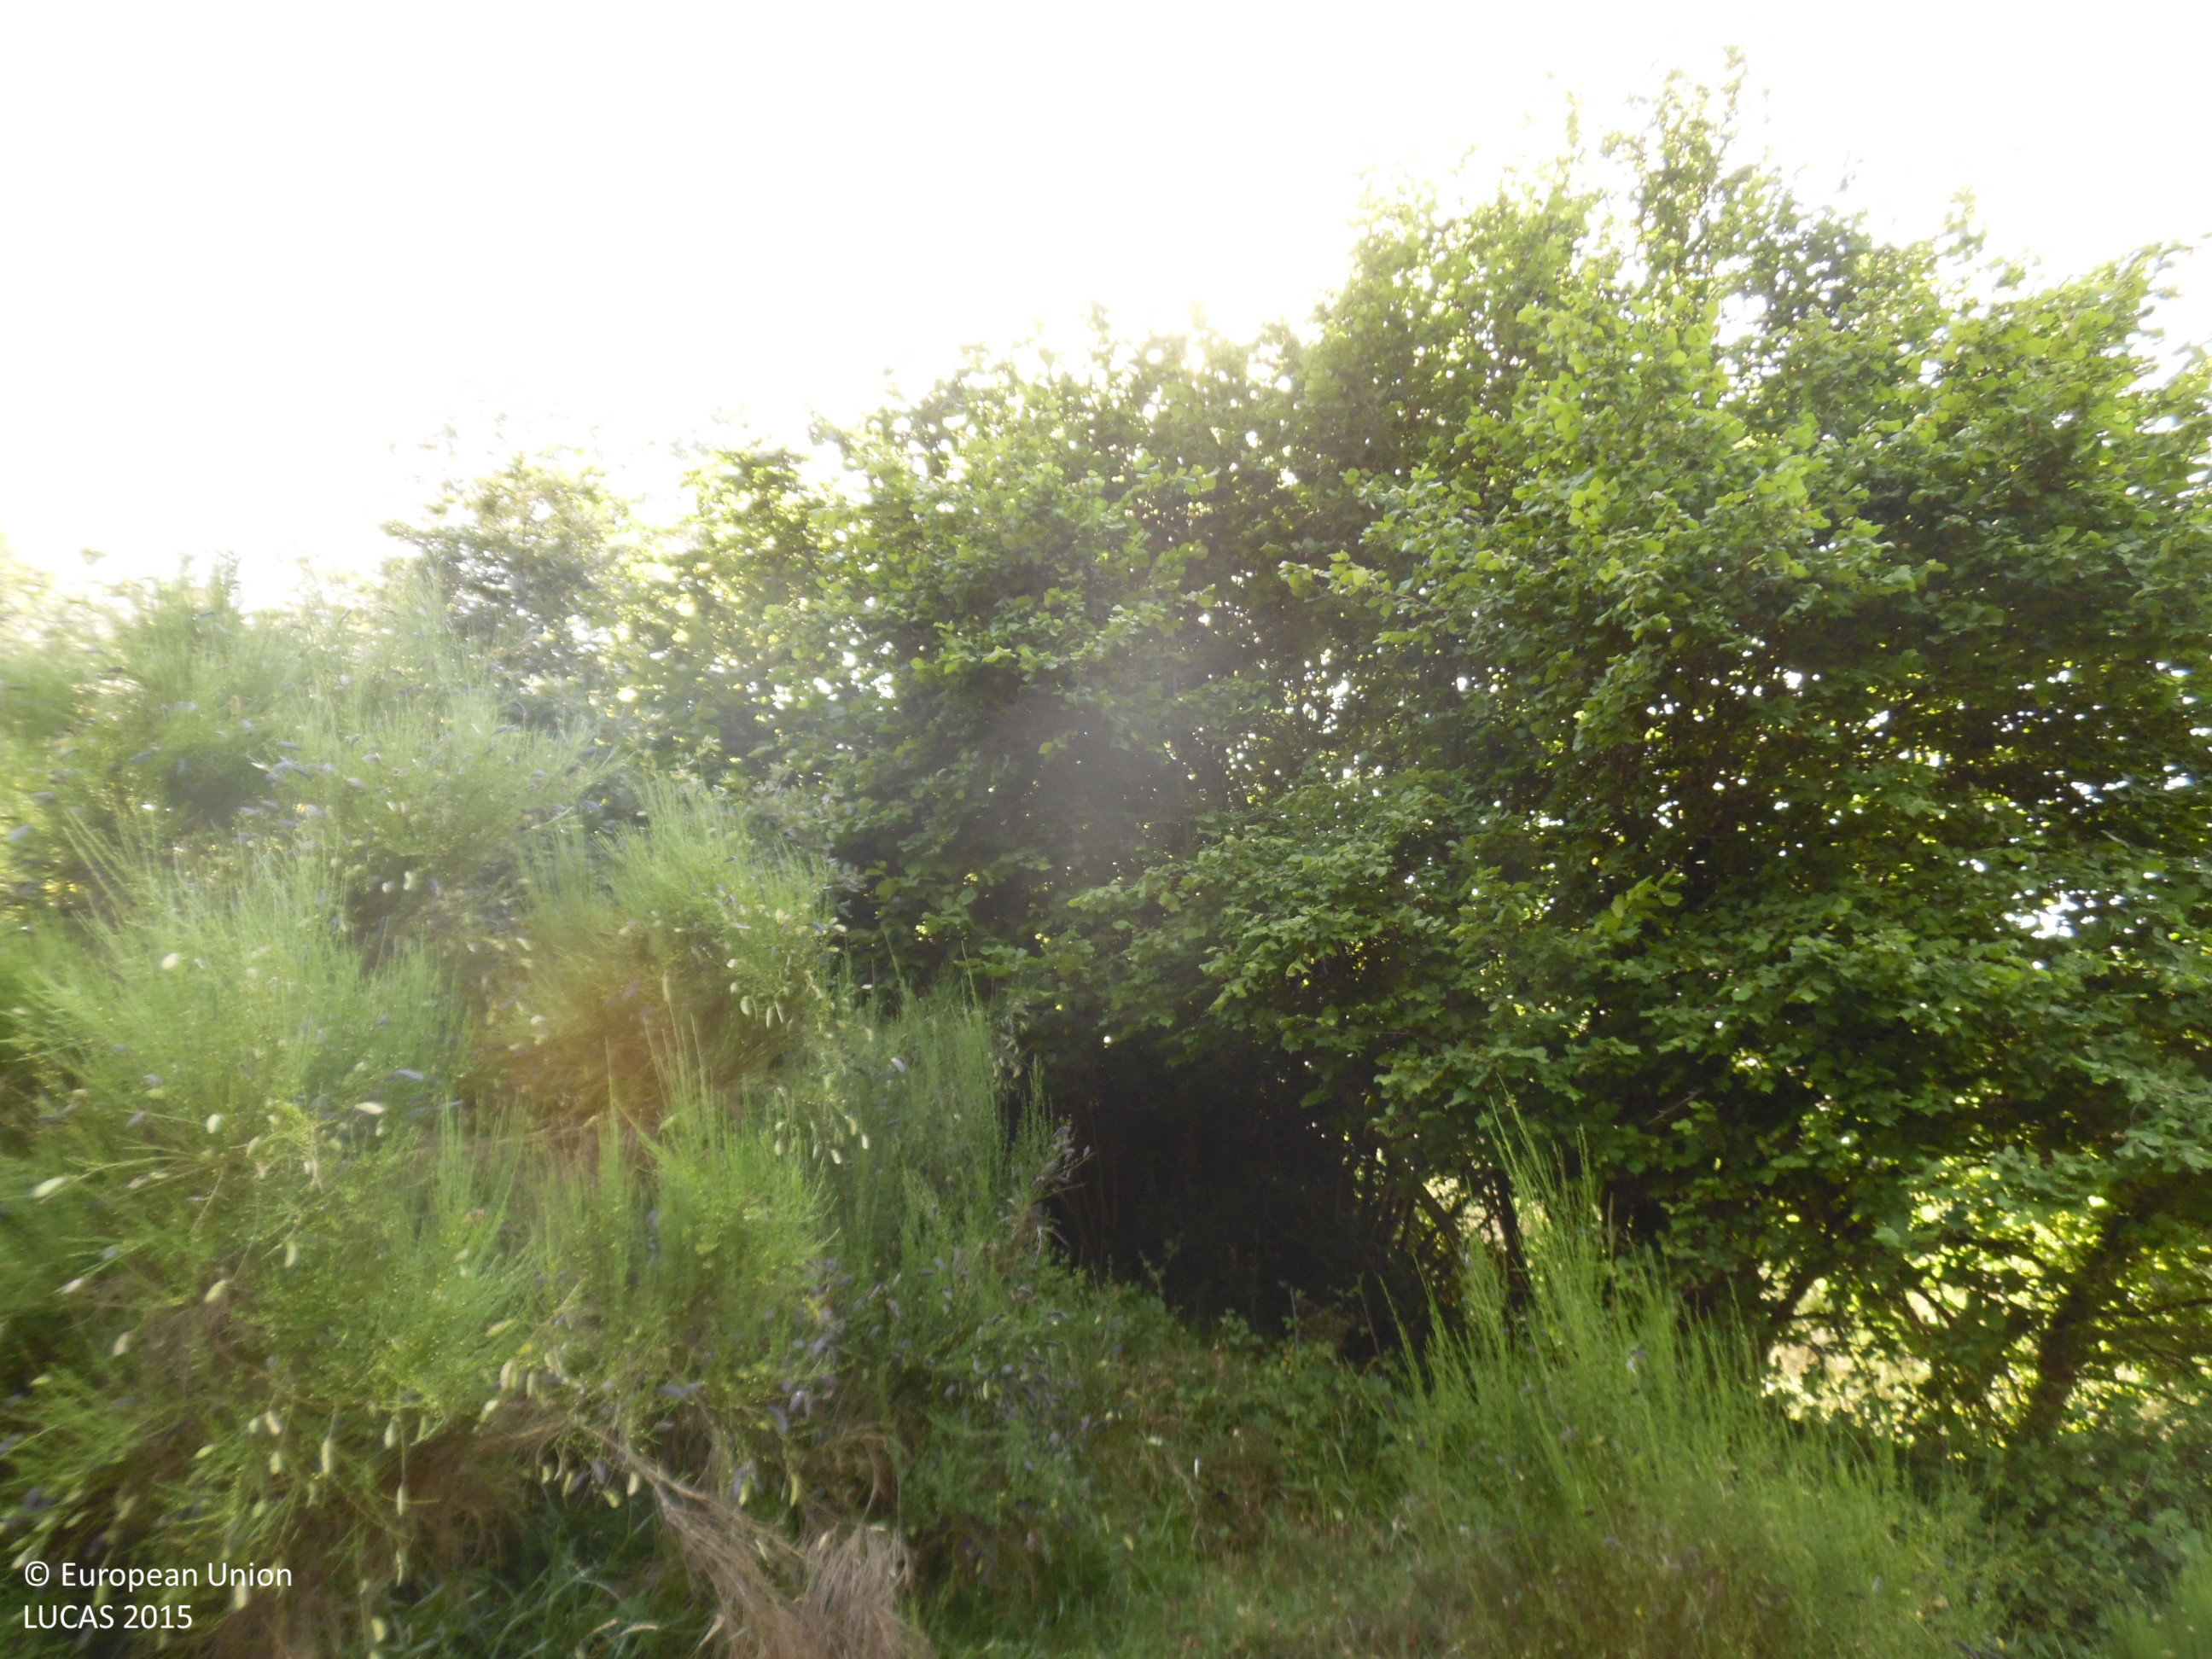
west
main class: Woodland
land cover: Broadleaved woodland
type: thermophilous deciduous forest
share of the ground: 25 - 50 %
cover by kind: herbaceous plants 50 %, broadleaved forest trees 30 %, shrubs 20 %
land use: Agriculture (excluding fallow land and kitchen gardens)
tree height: > 5 m
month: July
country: ES
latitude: 43.1312
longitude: -6.2597
